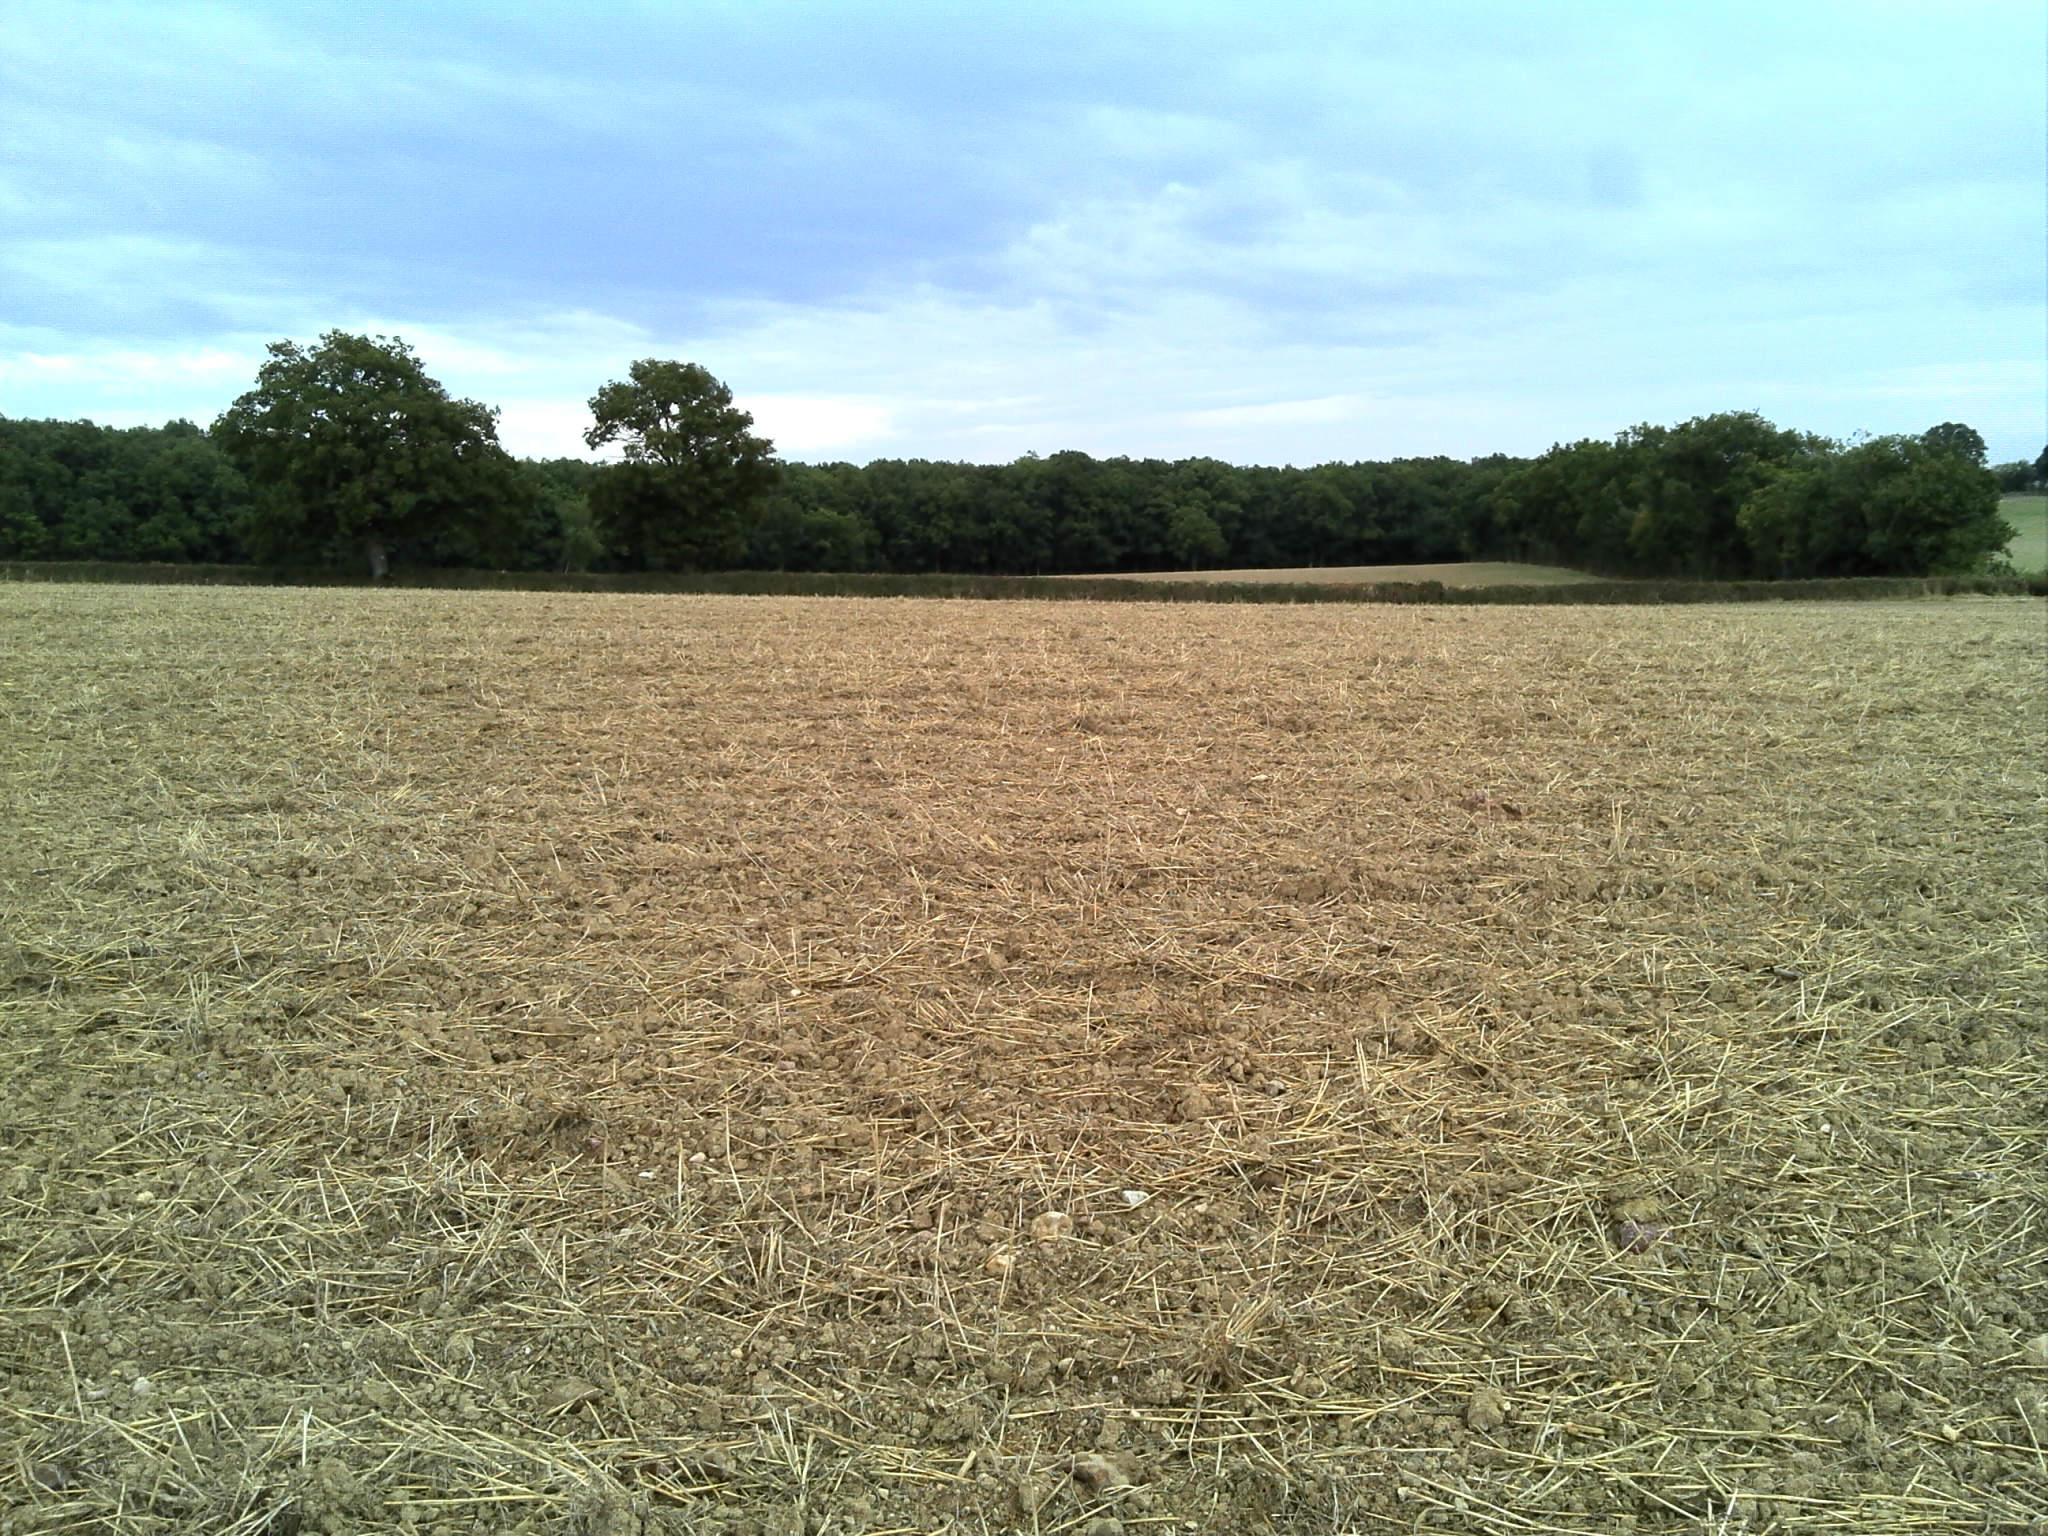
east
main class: Cropland
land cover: Common wheat
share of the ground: > 75 %
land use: Agriculture (excluding fallow land and kitchen gardens)
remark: Tilled/Sowed
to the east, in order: Common wheat; Managed hedges; Ditches and canals; Grassland without tree/shrub cover
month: August
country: FR
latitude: 46.6247
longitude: 2.1700
